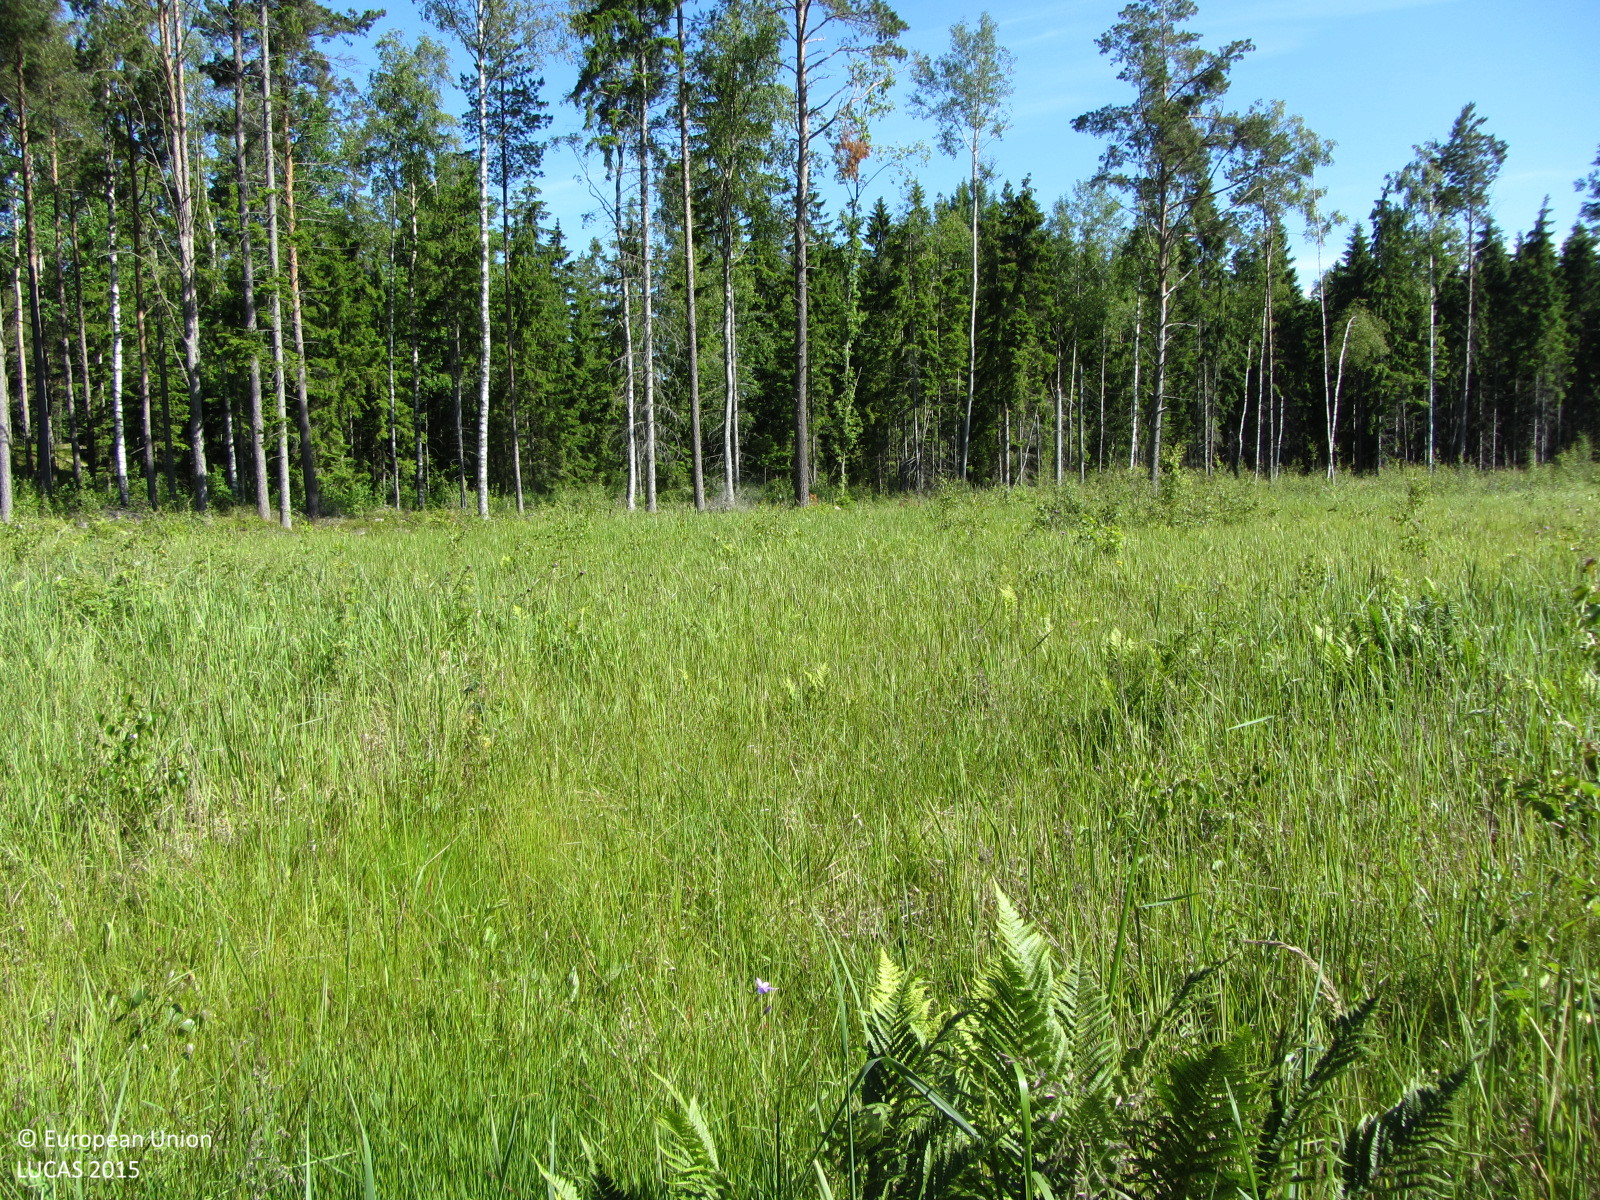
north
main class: Grassland
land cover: Grassland with sparse tree/shrub cover
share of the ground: > 75 %
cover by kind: herbaceous plants 90 %, broadleaved forest trees 5 %, shrubs 5 %
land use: Residential
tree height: < 5 m
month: July
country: FI
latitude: 59.8412
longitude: 23.0926
